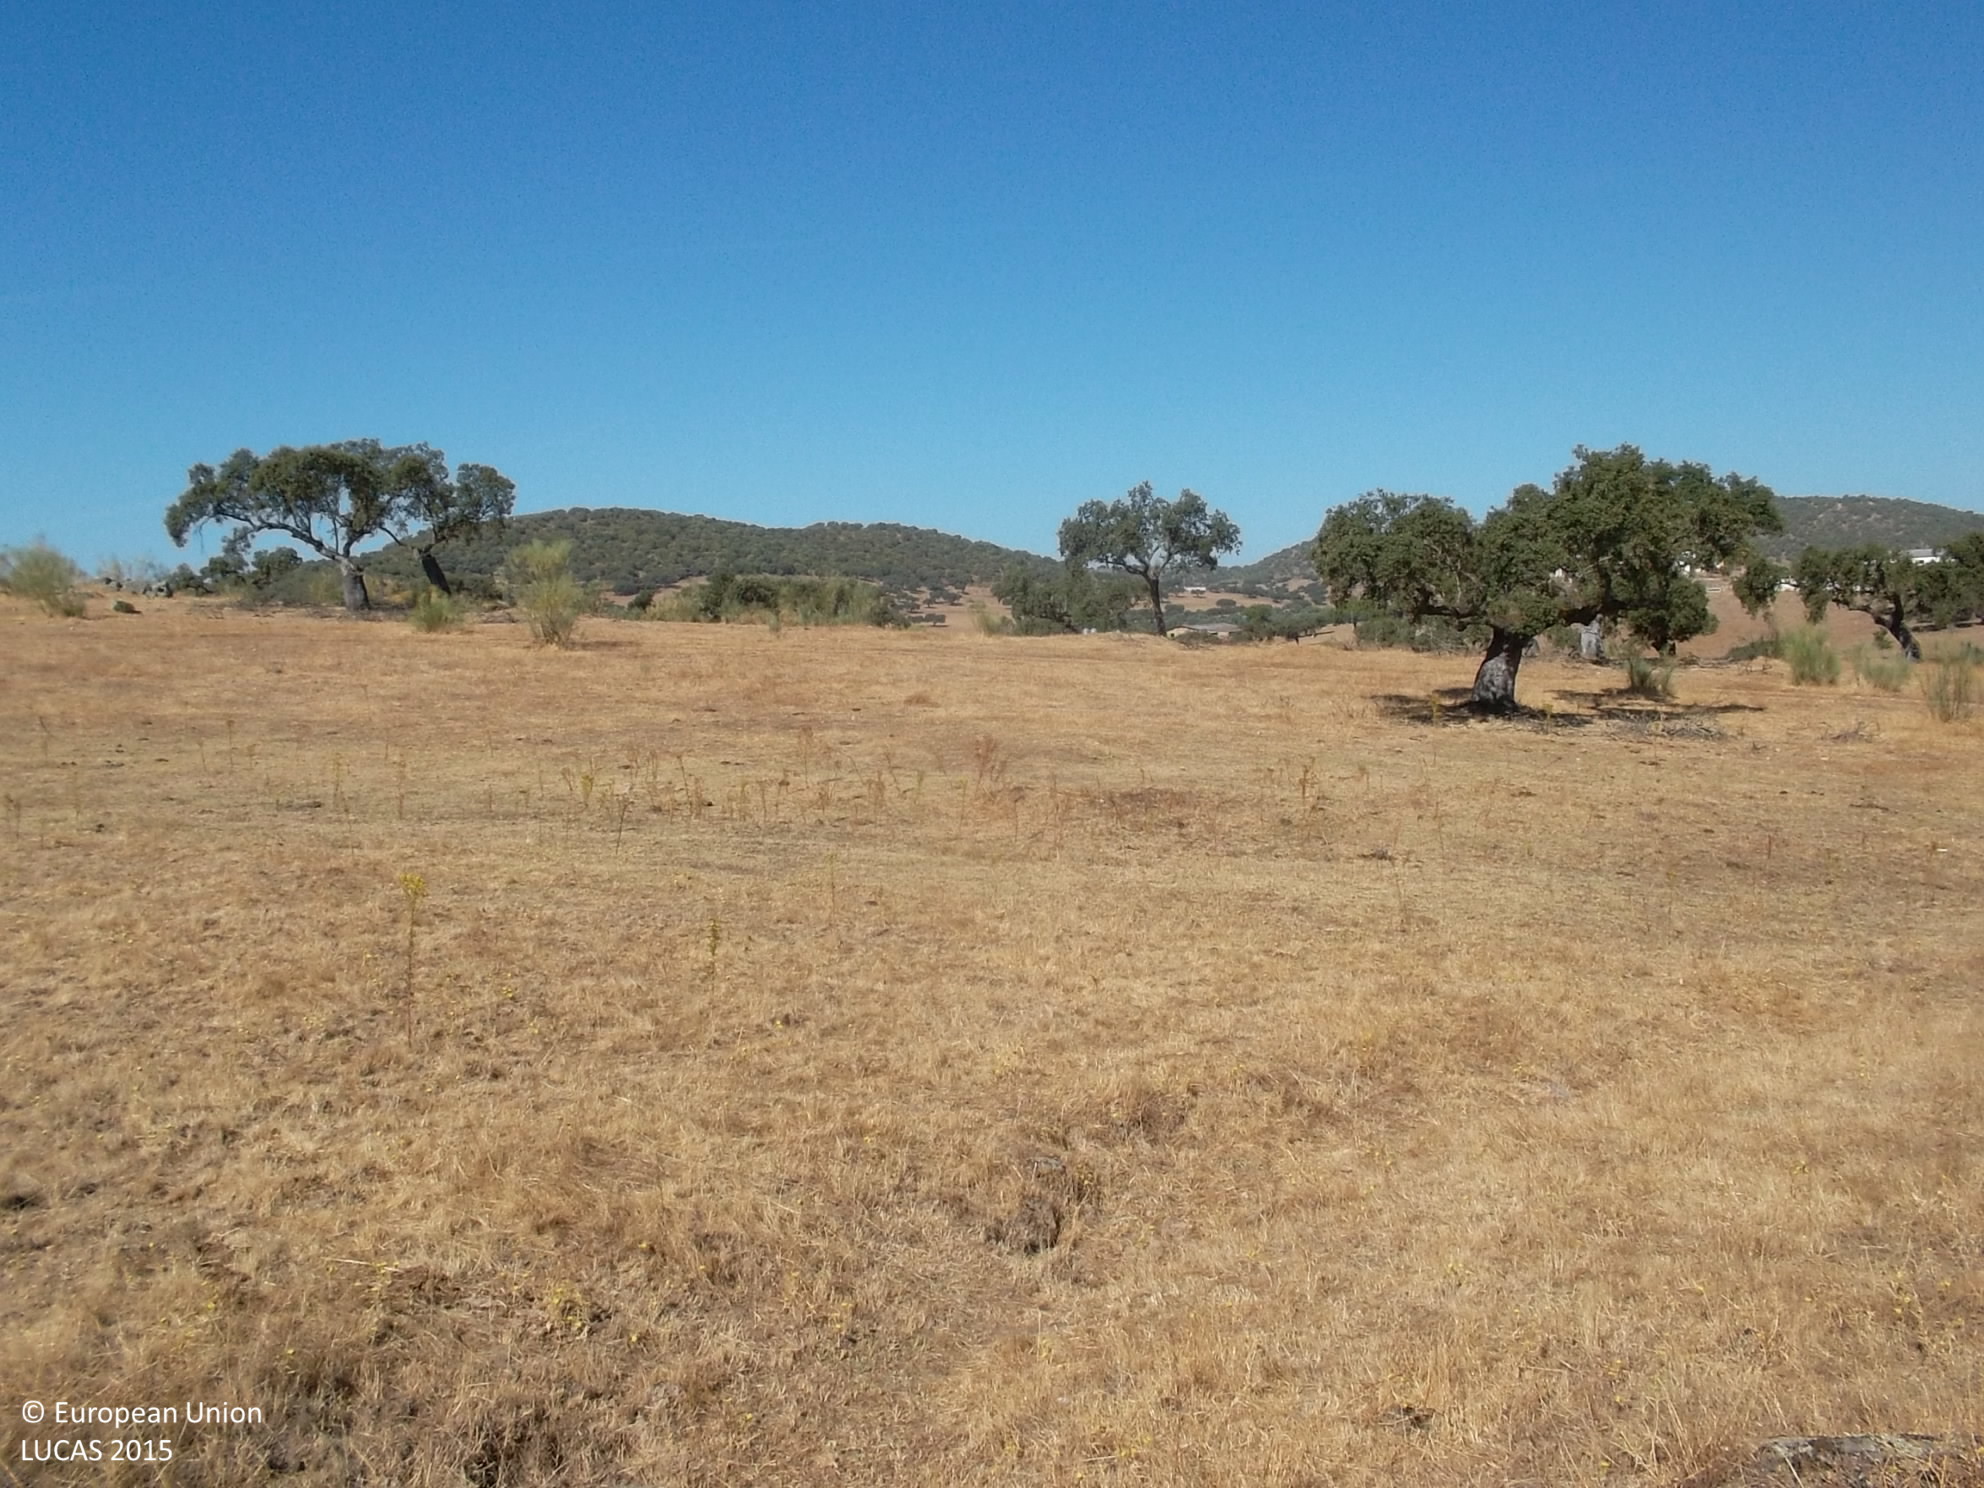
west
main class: Woodland
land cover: Broadleaved woodland
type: broadleaved evergreen forest
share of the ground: 10 - 25 %
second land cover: Grassland without tree/shrub cover
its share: > 75 %
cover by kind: herbaceous plants 85 %, broadleaved forest trees 15 %
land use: Forestry
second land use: Agriculture (excluding fallow land and kitchen gardens)
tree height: > 5 m
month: August
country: ES
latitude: 38.3173
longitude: -6.6487
